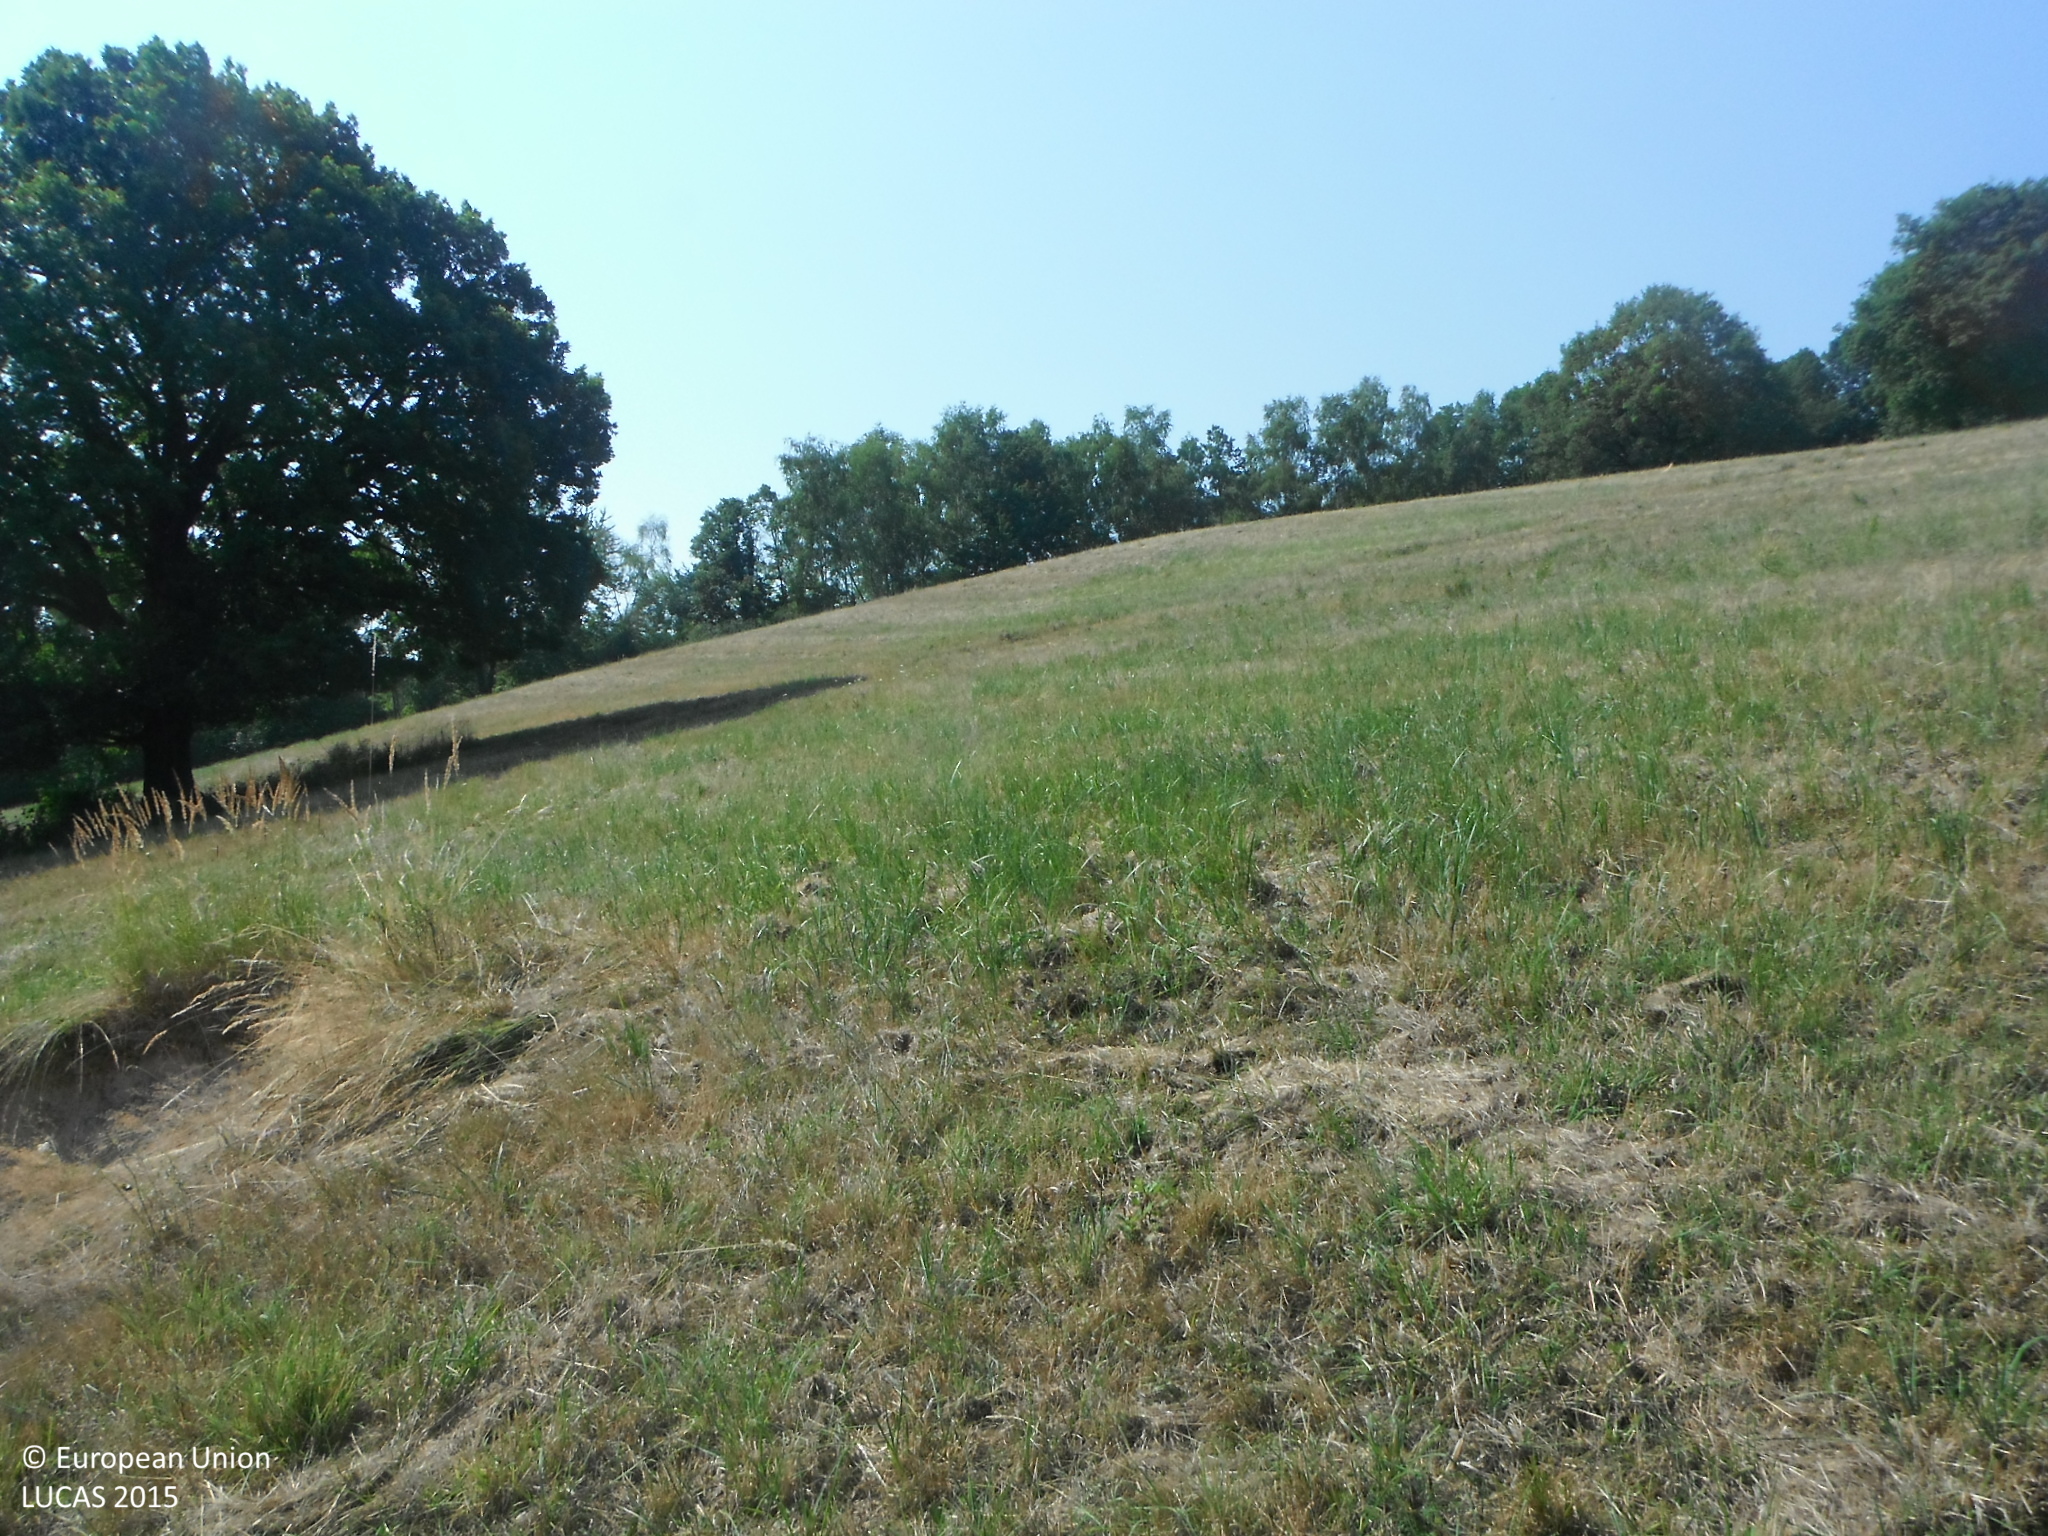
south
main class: Grassland
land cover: Grassland without tree/shrub cover
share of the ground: > 75 %
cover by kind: herbaceous plants 95 %, unconsolidated bare surface 5 %
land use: Agriculture (excluding fallow land and kitchen gardens)
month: August
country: SK
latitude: 48.8019
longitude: 17.9786
